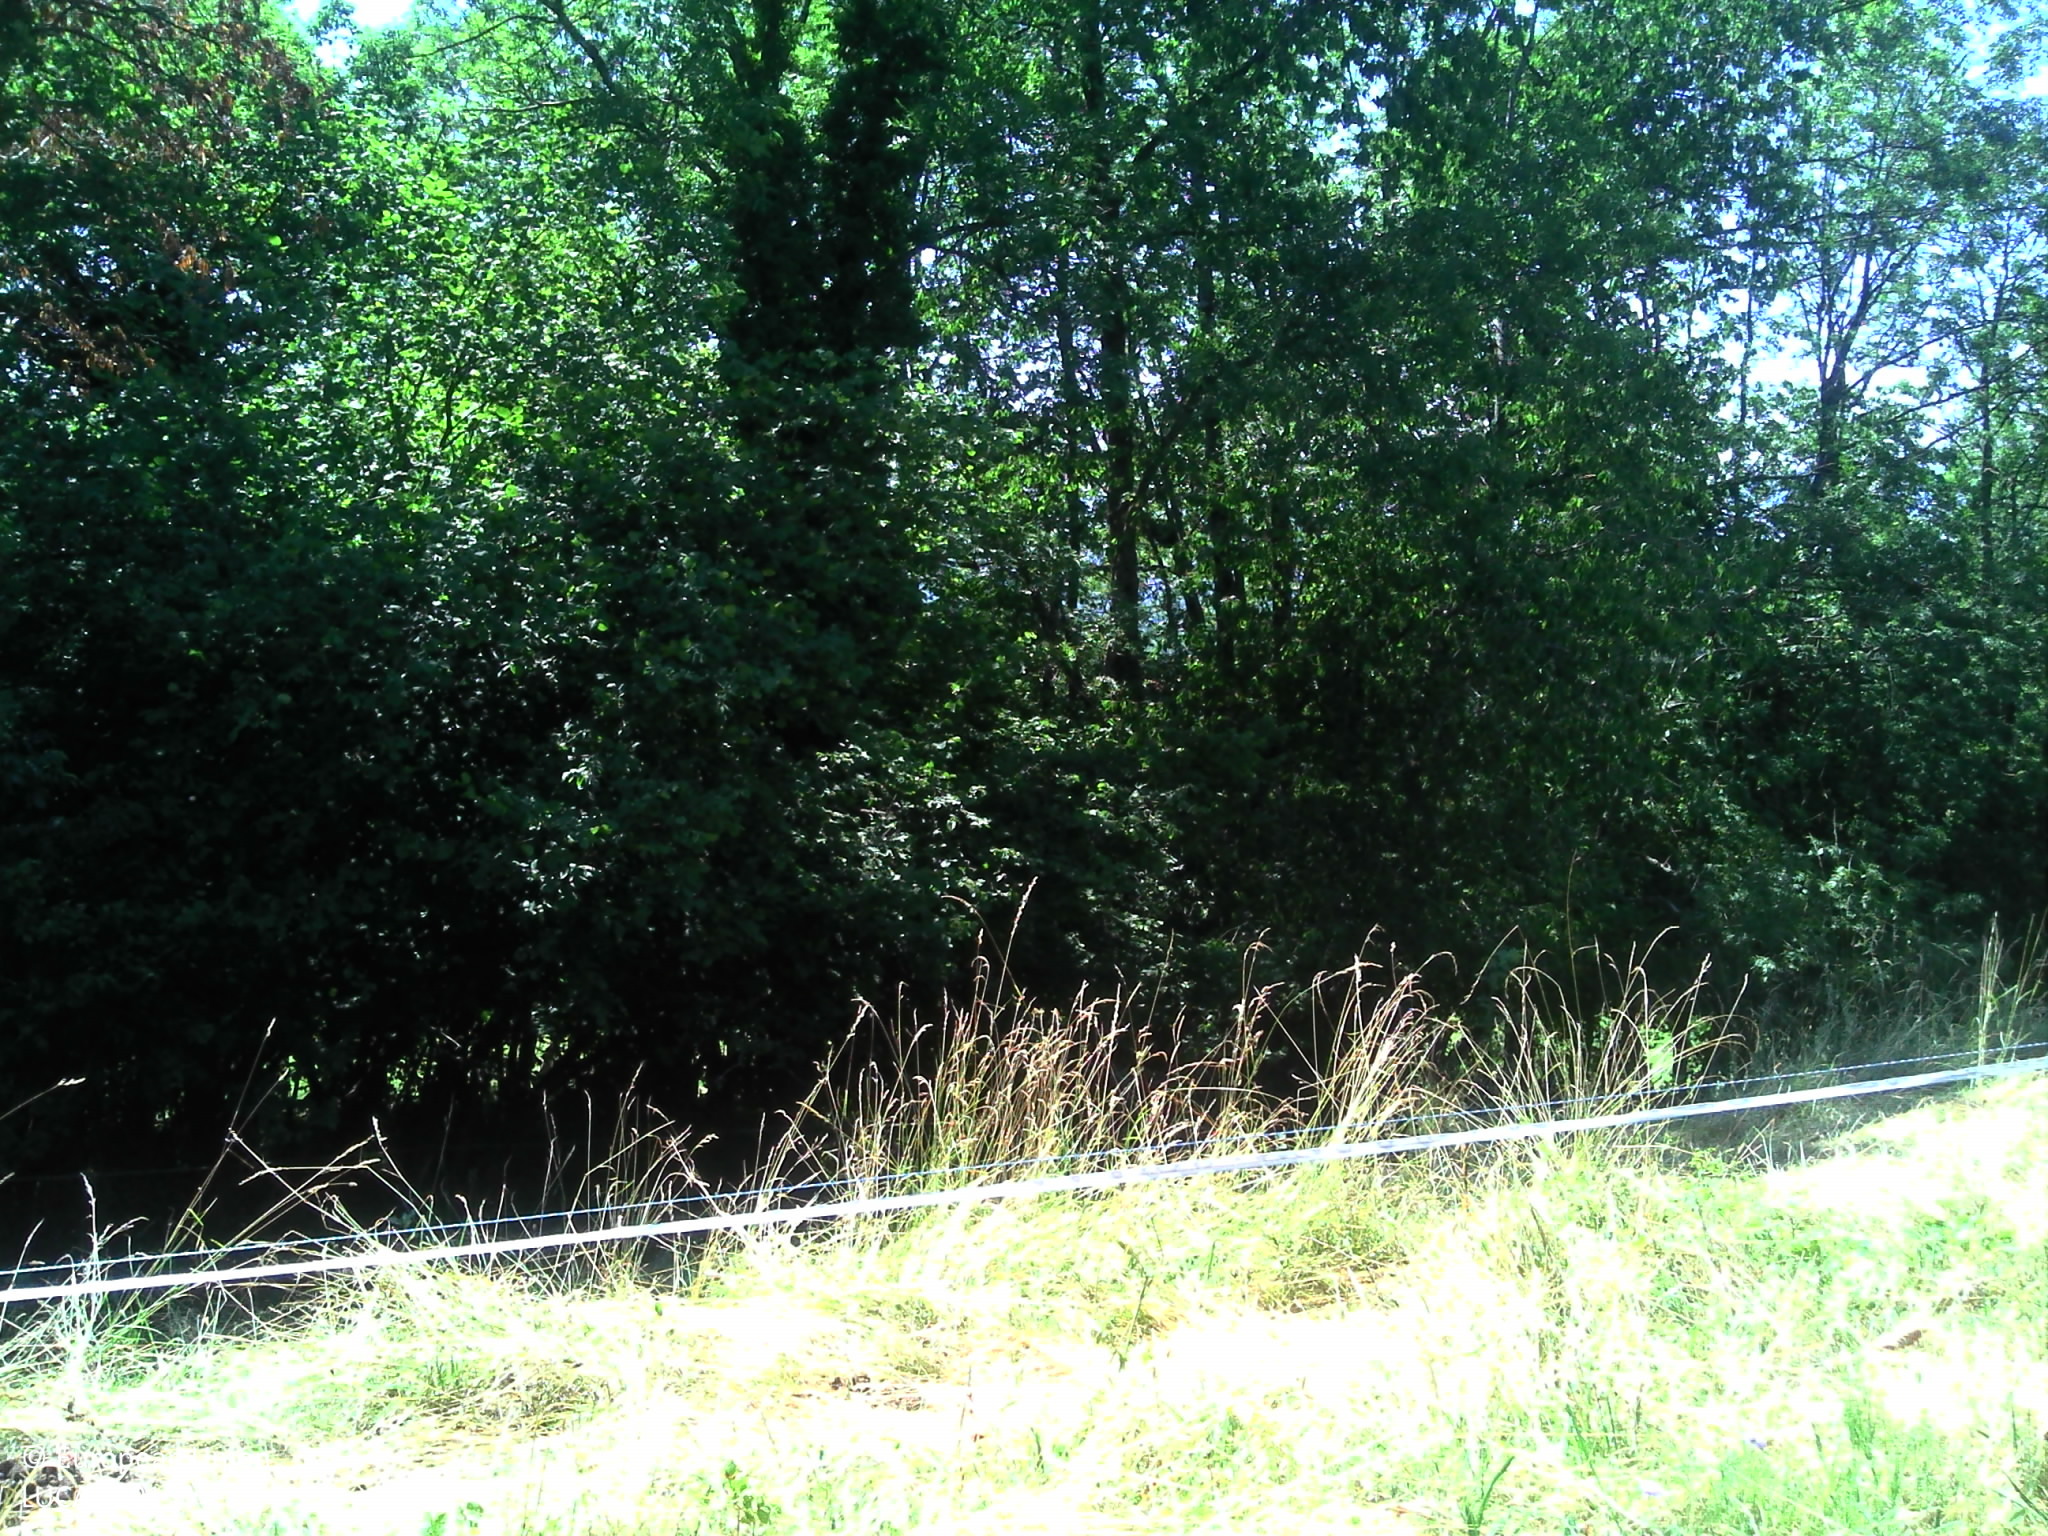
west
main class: Grassland
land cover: Grassland without tree/shrub cover
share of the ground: > 75 %
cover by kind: herbaceous plants 100 %
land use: Agriculture (excluding fallow land and kitchen gardens)
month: July
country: FR
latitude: 46.2926
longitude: 6.4595
